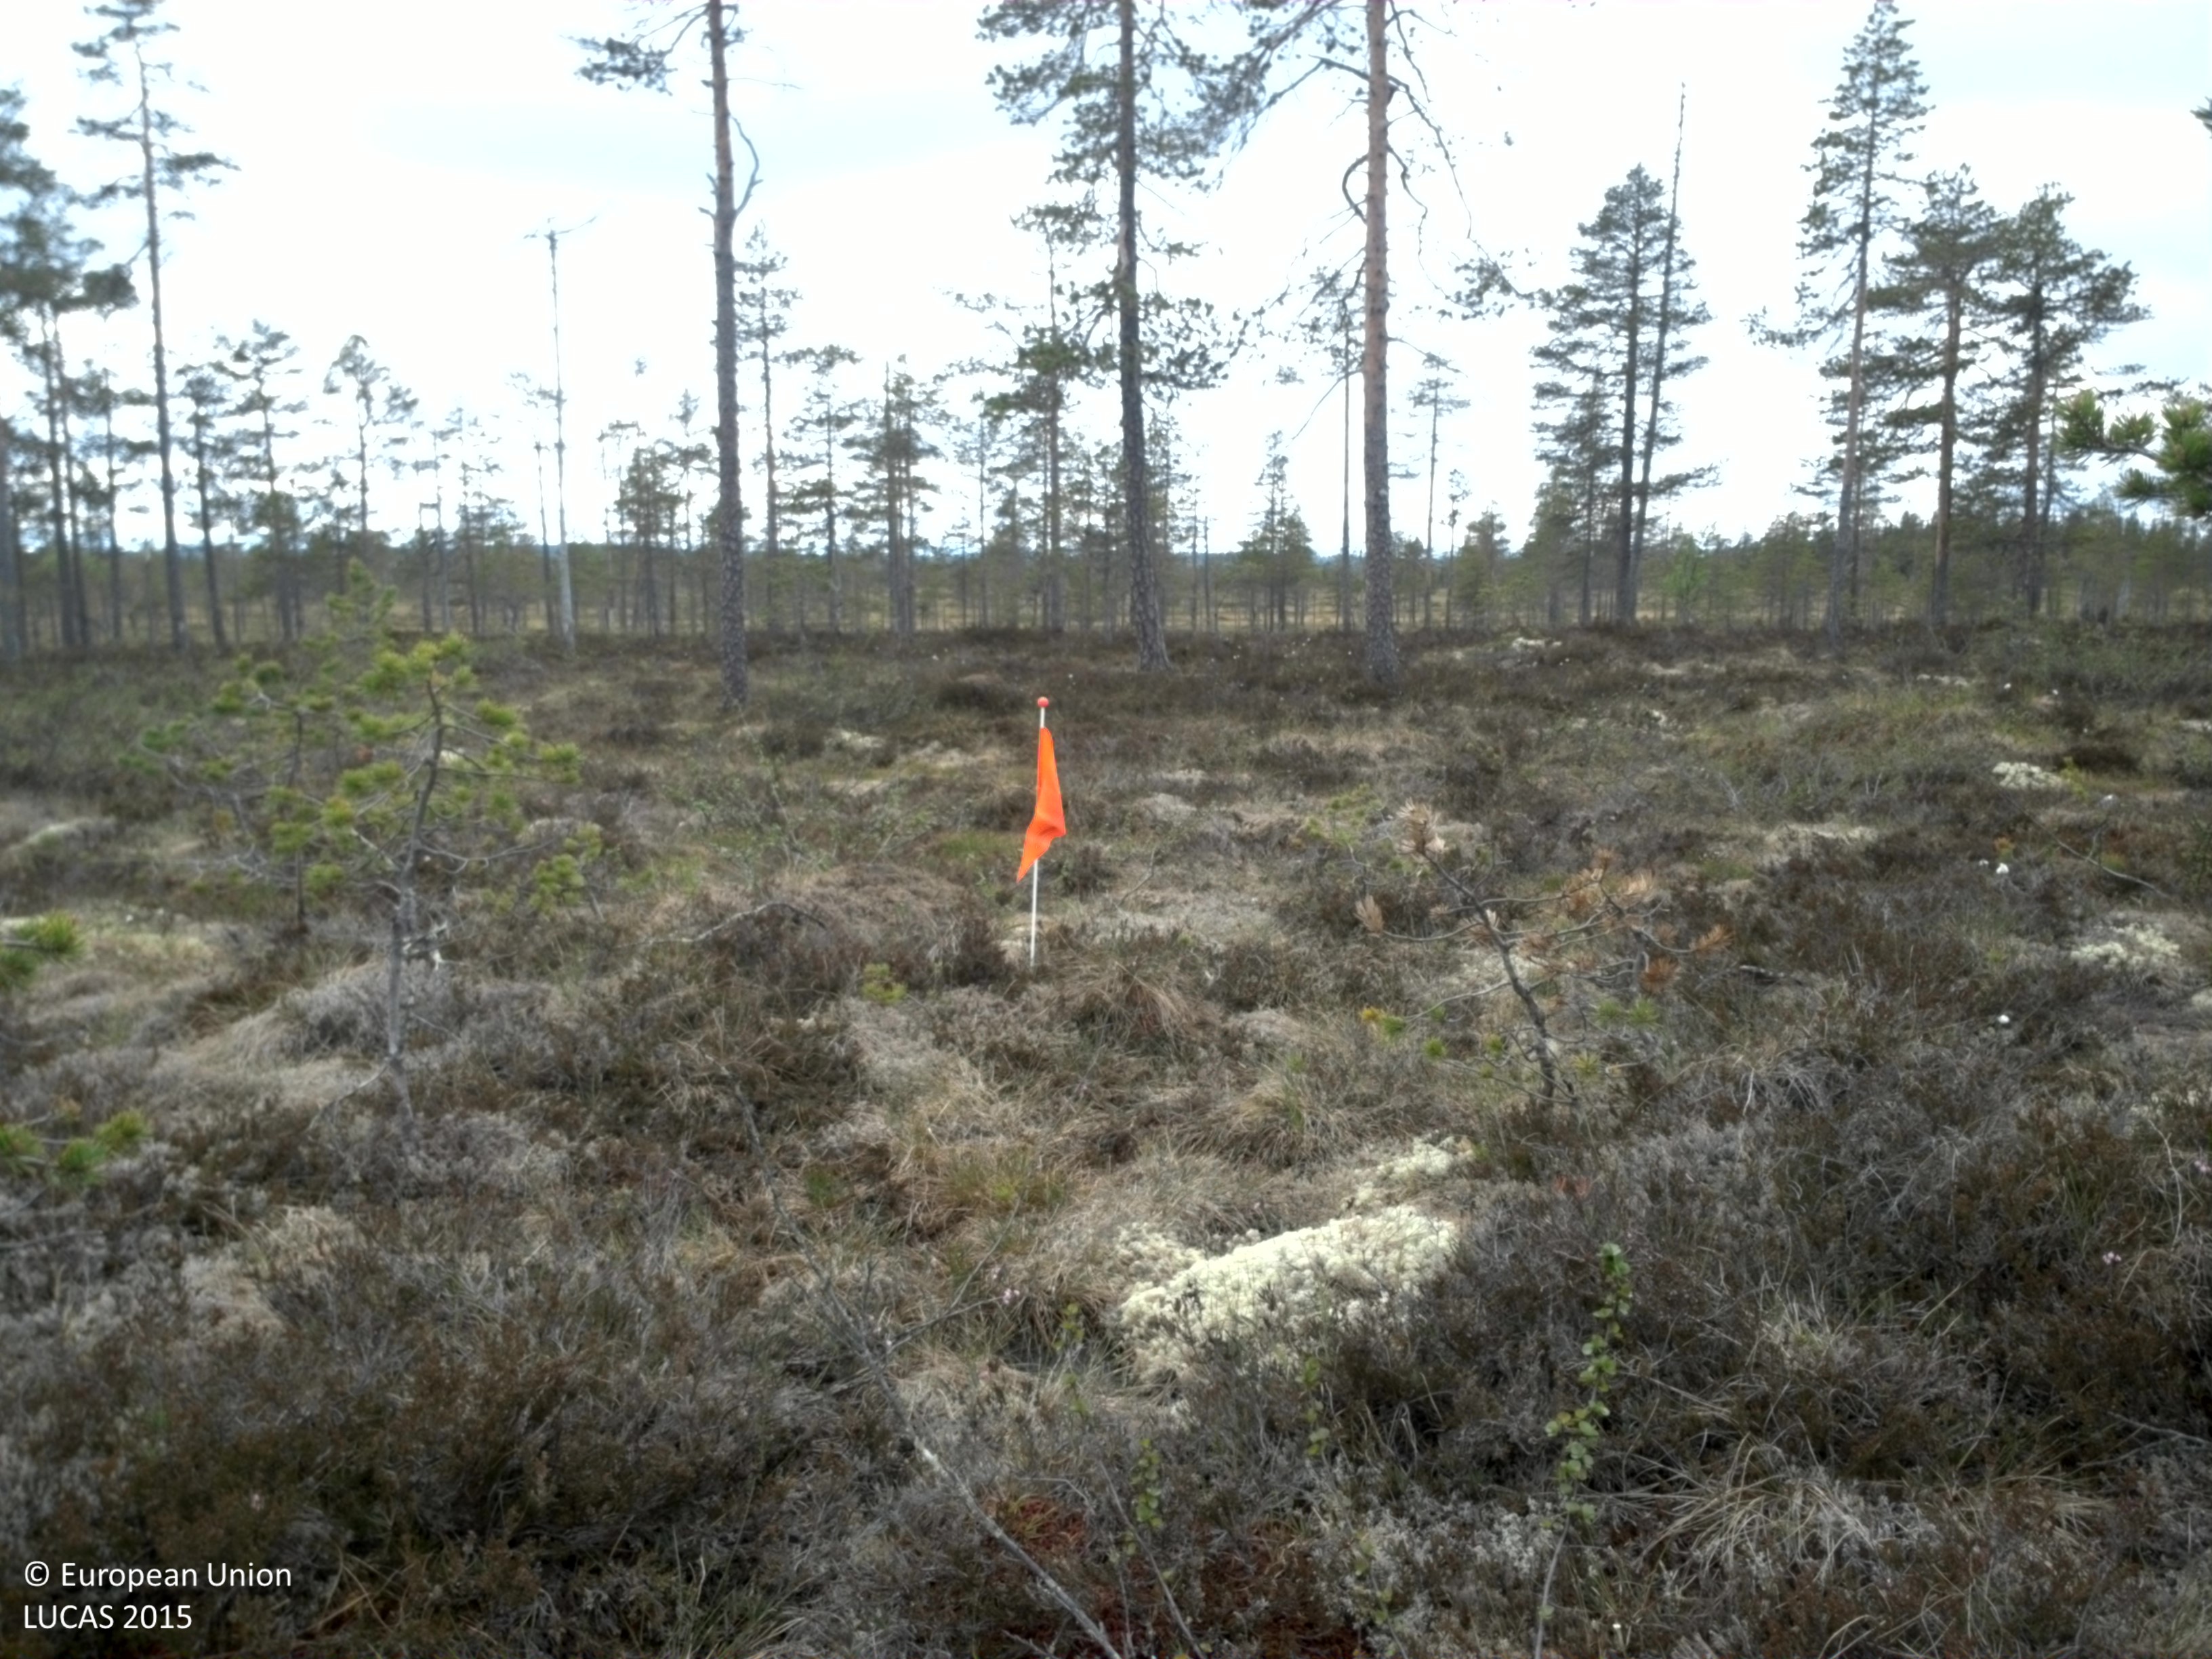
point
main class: Woodland
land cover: Pine dominated coniferous woodland
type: boreal forest
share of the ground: 10 - 25 %
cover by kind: lichens and mosses 35 %, shrubs 30 %, herbaceous plants 25 %, coniferous forest trees 10 %
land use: Semi-natural and natural areas not in use
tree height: > 5 m
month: June
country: SE
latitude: 61.4515
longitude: 13.5699
